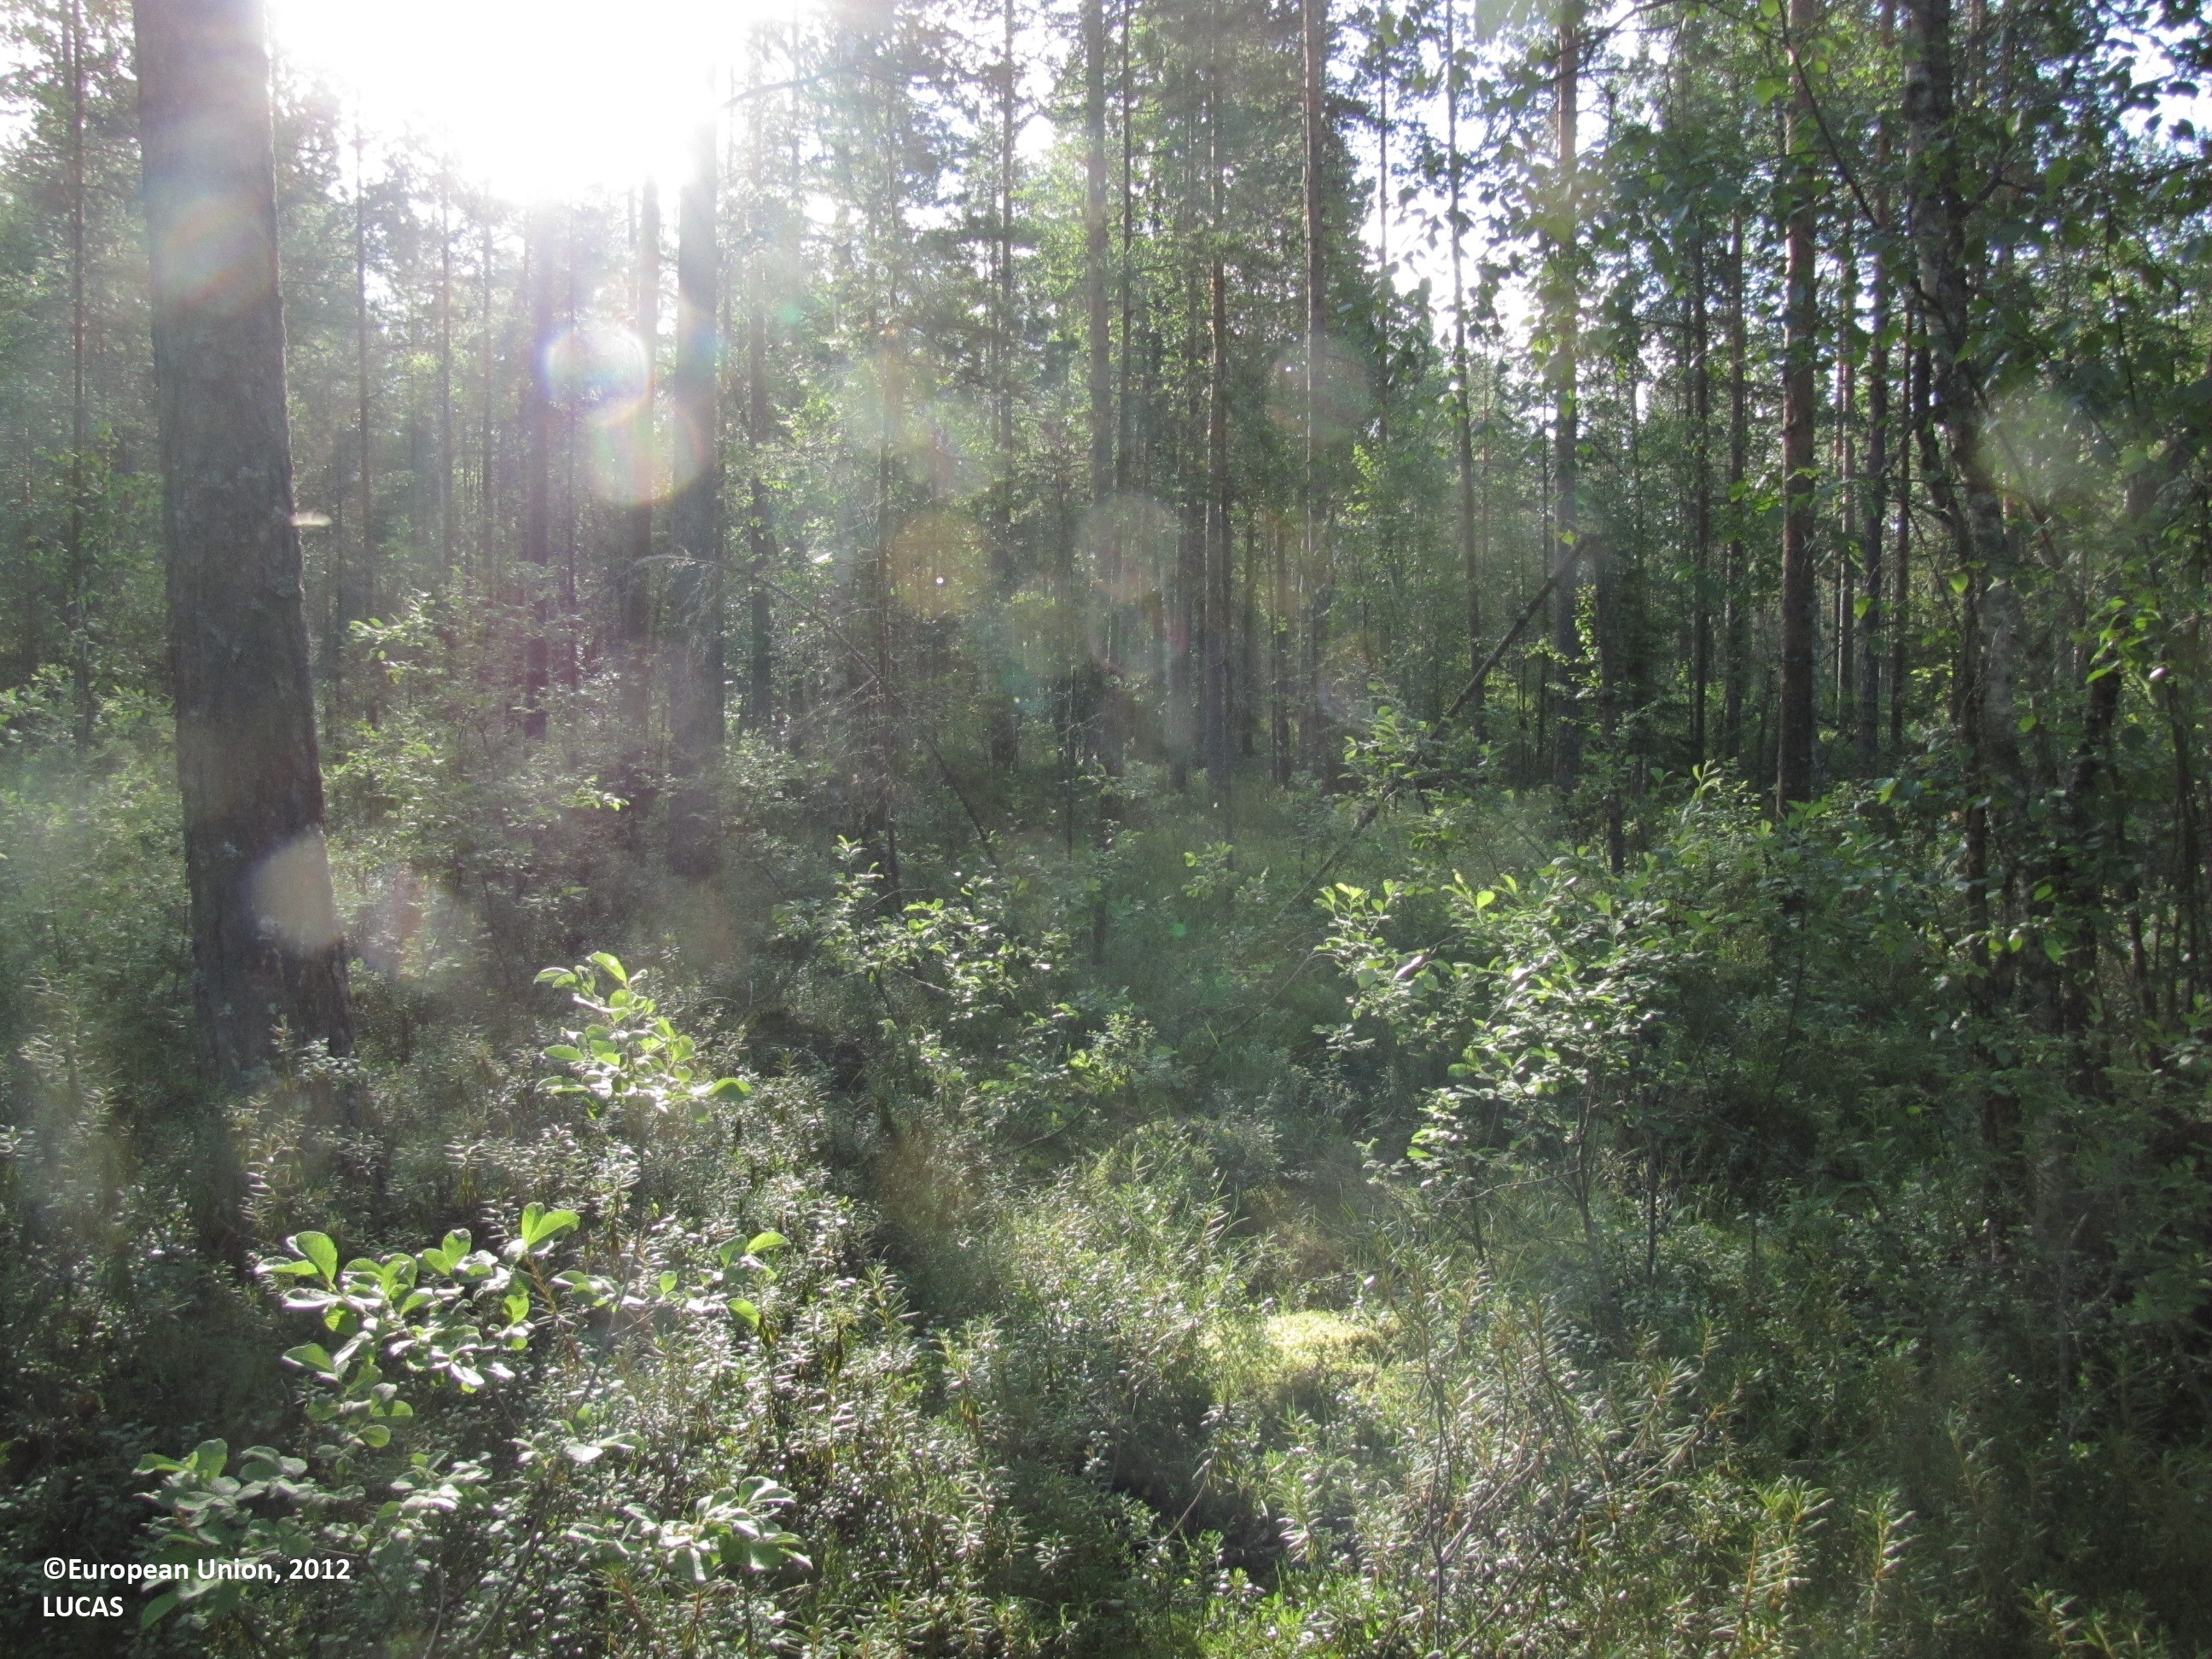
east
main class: Woodland
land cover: Pine dominated coniferous woodland
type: mire and swamp forests
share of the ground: > 75 %
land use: Forestry
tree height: > 5 m
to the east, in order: Pine dominated coniferous woodland; Ditches and canals; Pine dominated coniferous woodland
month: July
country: FI
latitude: 62.6062
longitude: 23.2949
